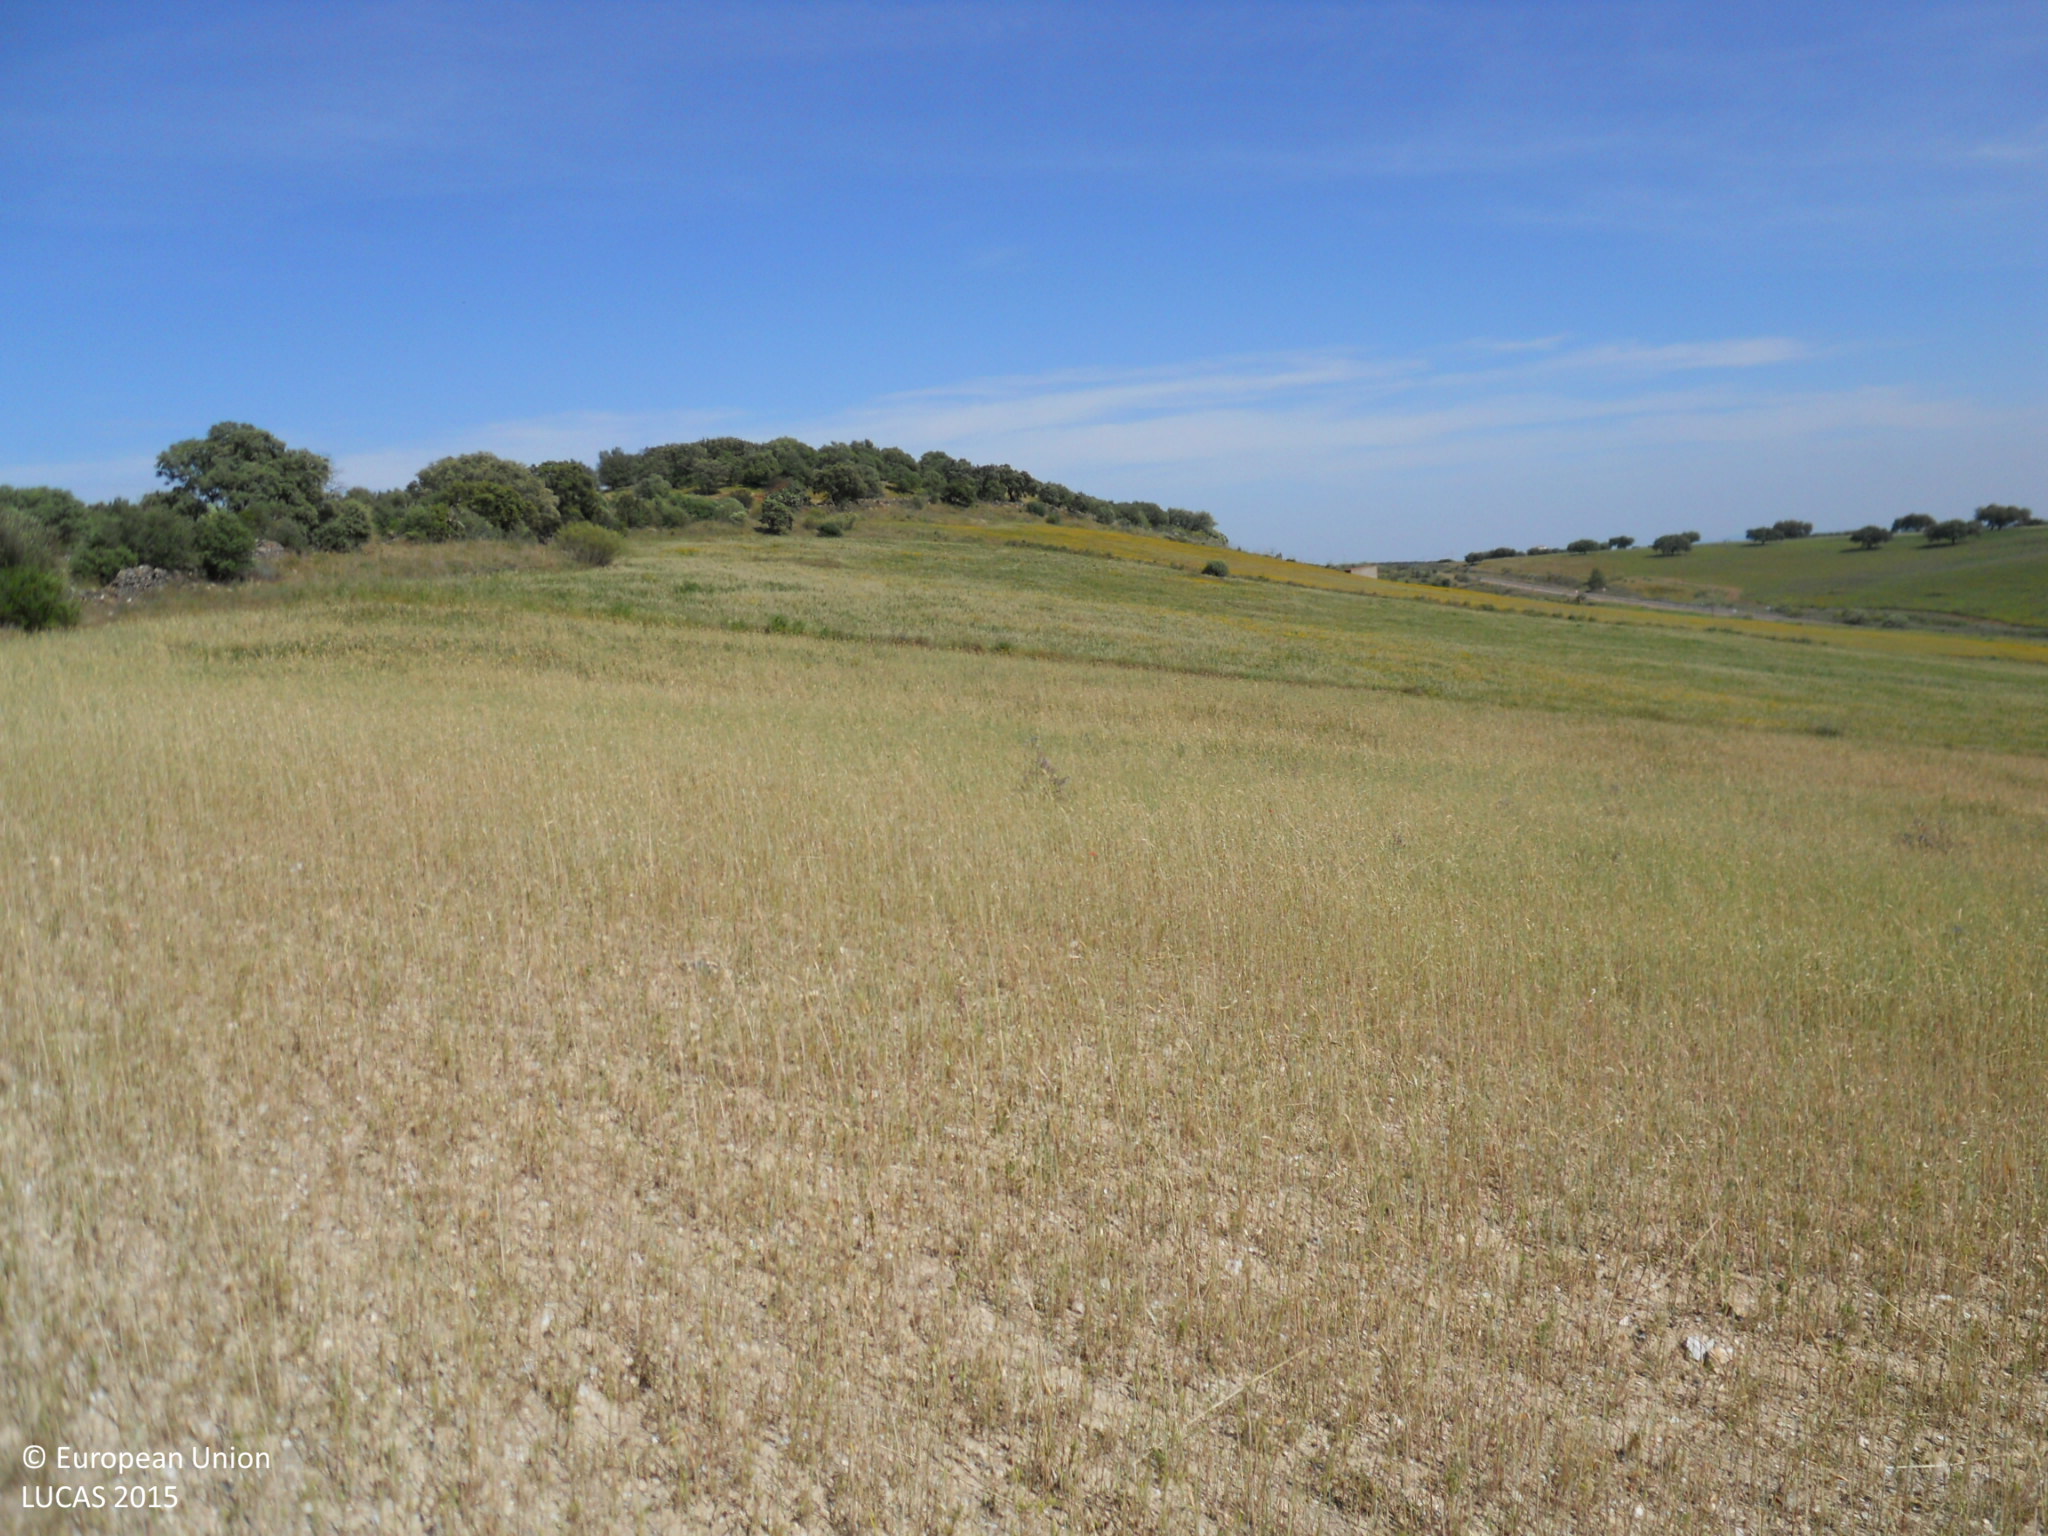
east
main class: Cropland
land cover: Mixed cereals for fodder
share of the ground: > 75 %
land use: Agriculture (excluding fallow land and kitchen gardens)
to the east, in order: Mixed cereals for fodder; Grass margins; Mixed cereals for fodder; Grass margins; Mixed cereals for fodder
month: April
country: ES
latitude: 39.1328
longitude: -6.8341
